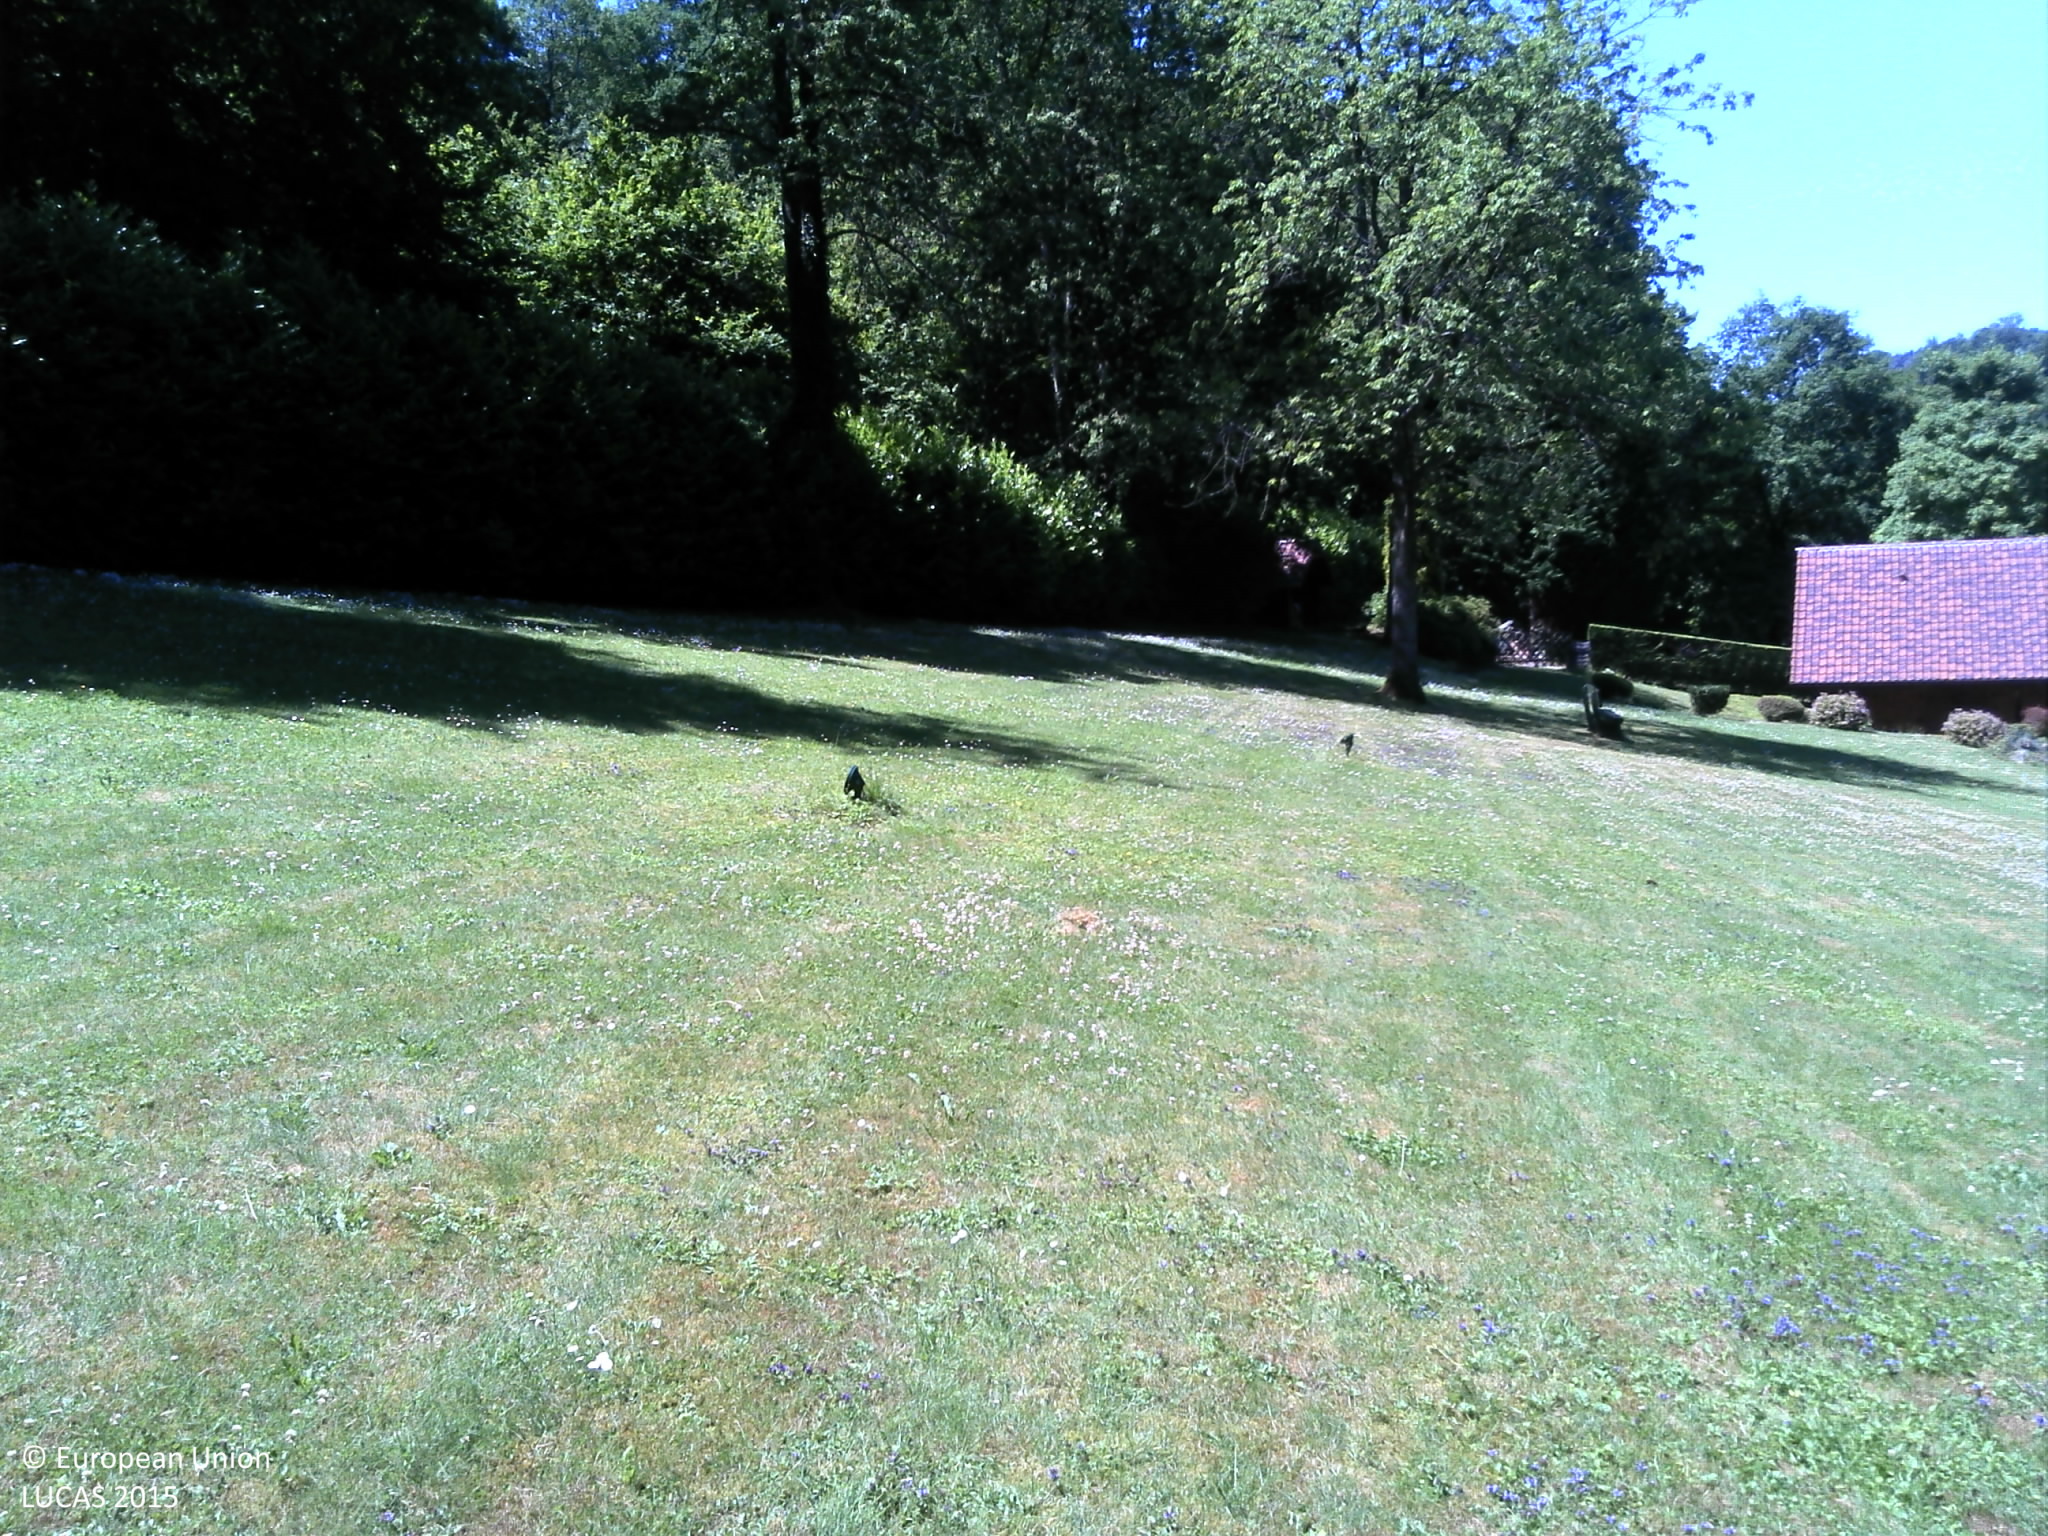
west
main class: Grassland
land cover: Grassland without tree/shrub cover
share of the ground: > 75 %
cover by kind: herbaceous plants 100 %
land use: Residential
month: June
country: FR
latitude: 49.3785
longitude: 6.0739
